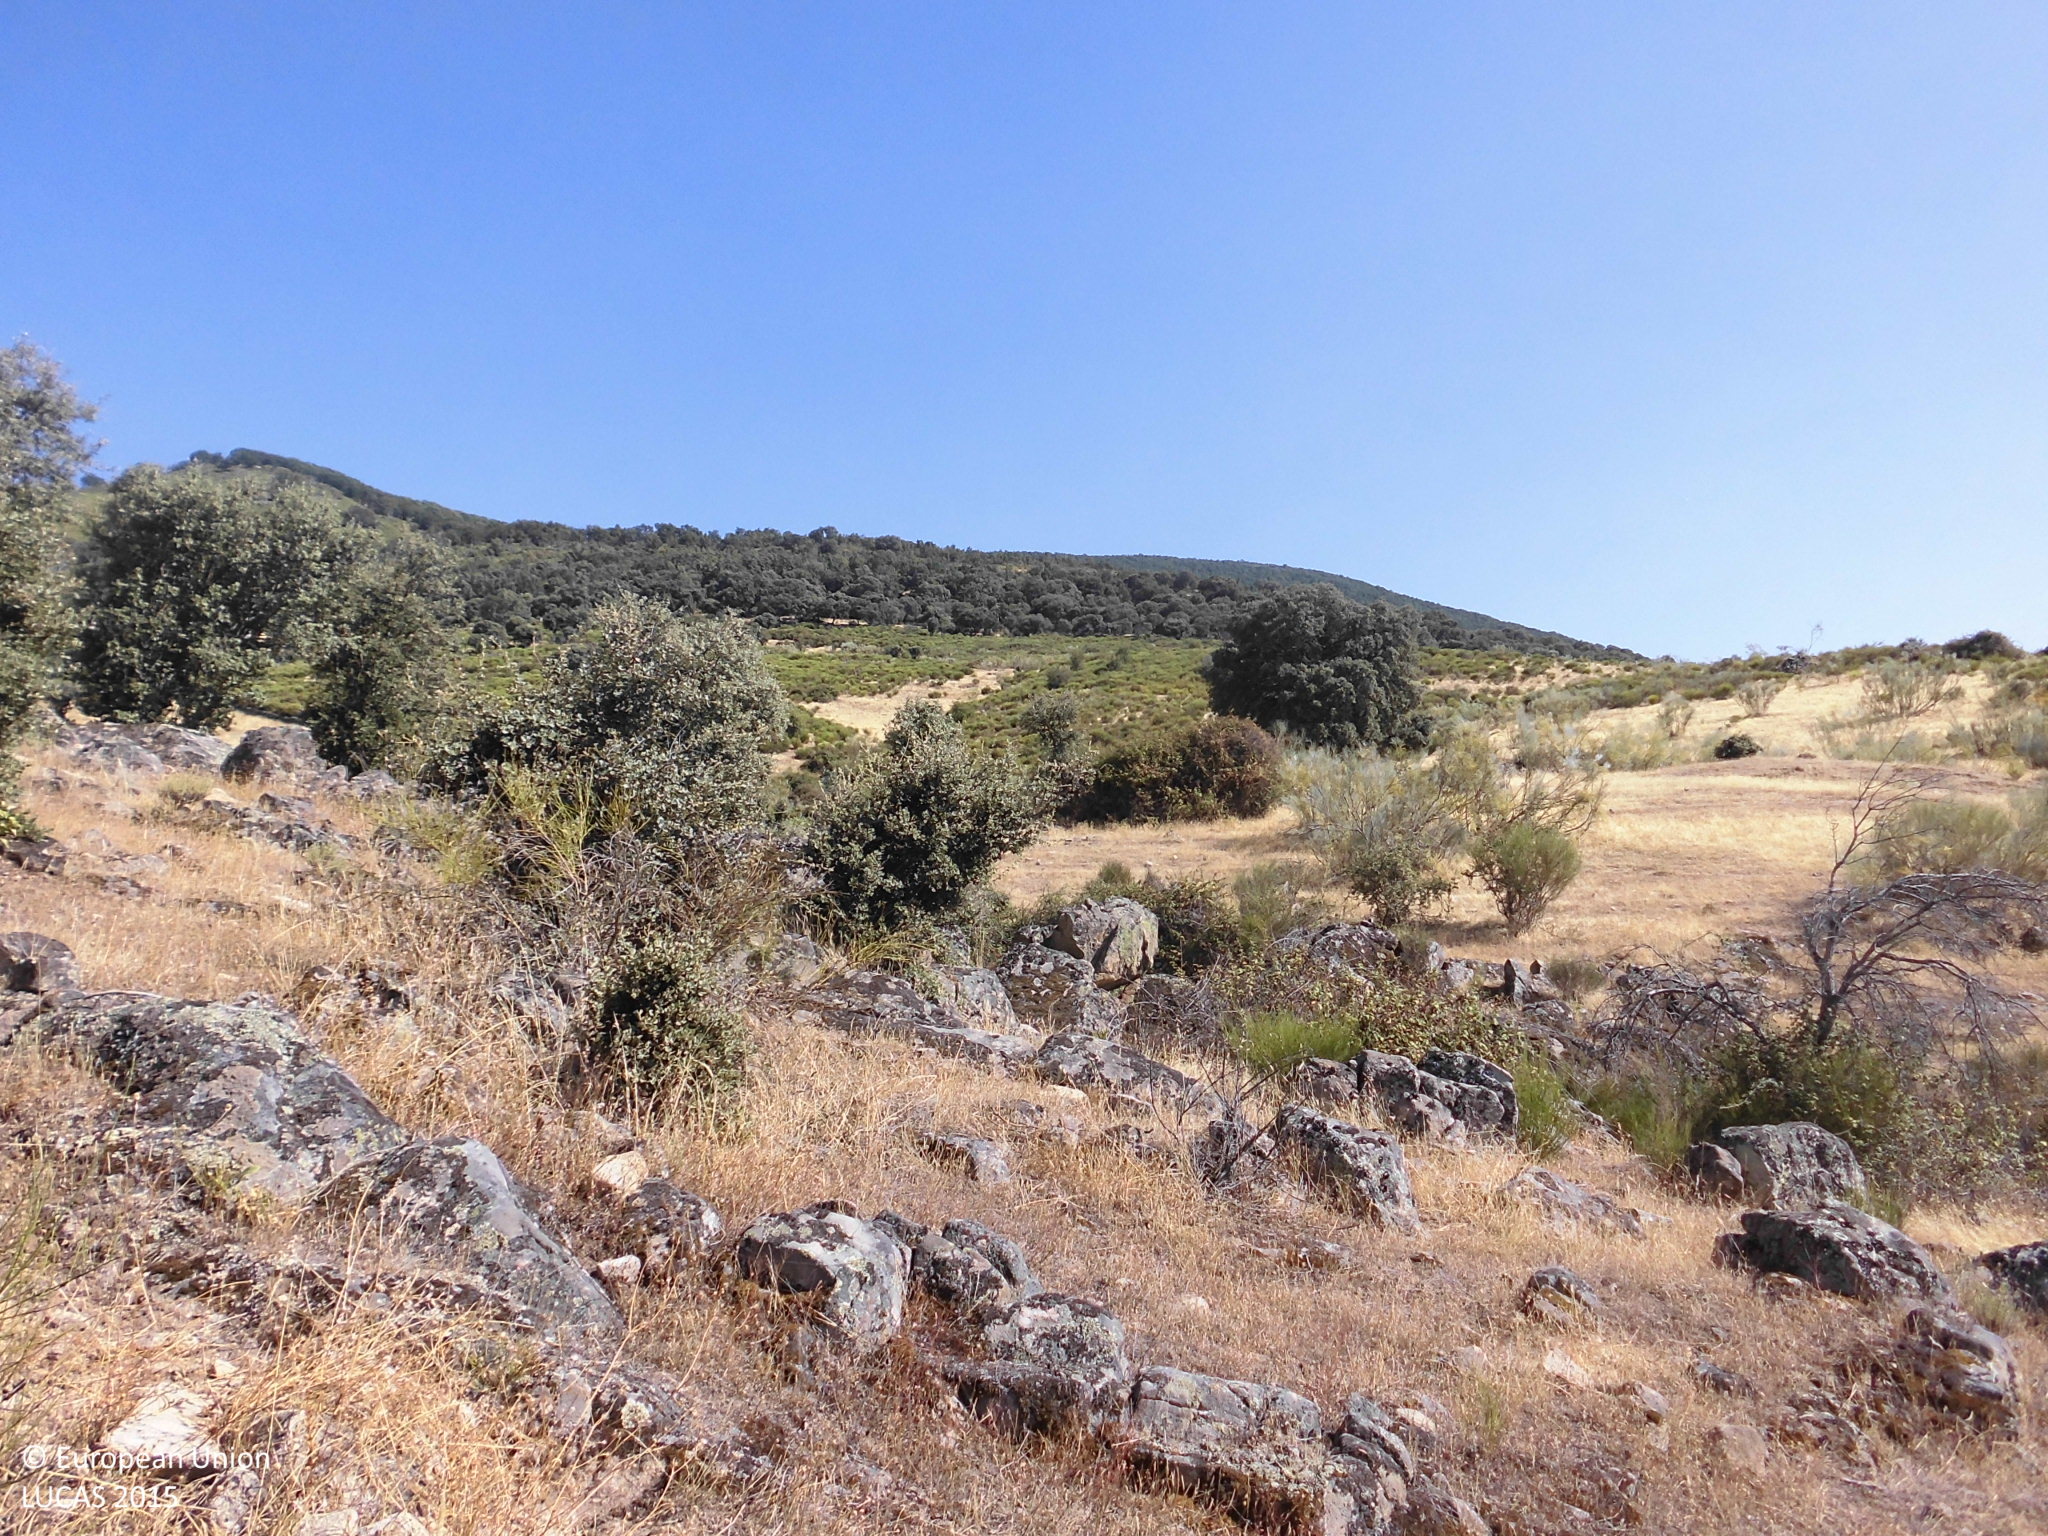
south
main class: Shrubland
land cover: Shrubland with sparse tree cover
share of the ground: 10 - 25 %
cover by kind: herbaceous plants 70 %, shrubs 25 %, broadleaved forest trees 5 %
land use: Agriculture (excluding fallow land and kitchen gardens)
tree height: > 5 m
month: July
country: ES
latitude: 40.1155
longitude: -6.0406
